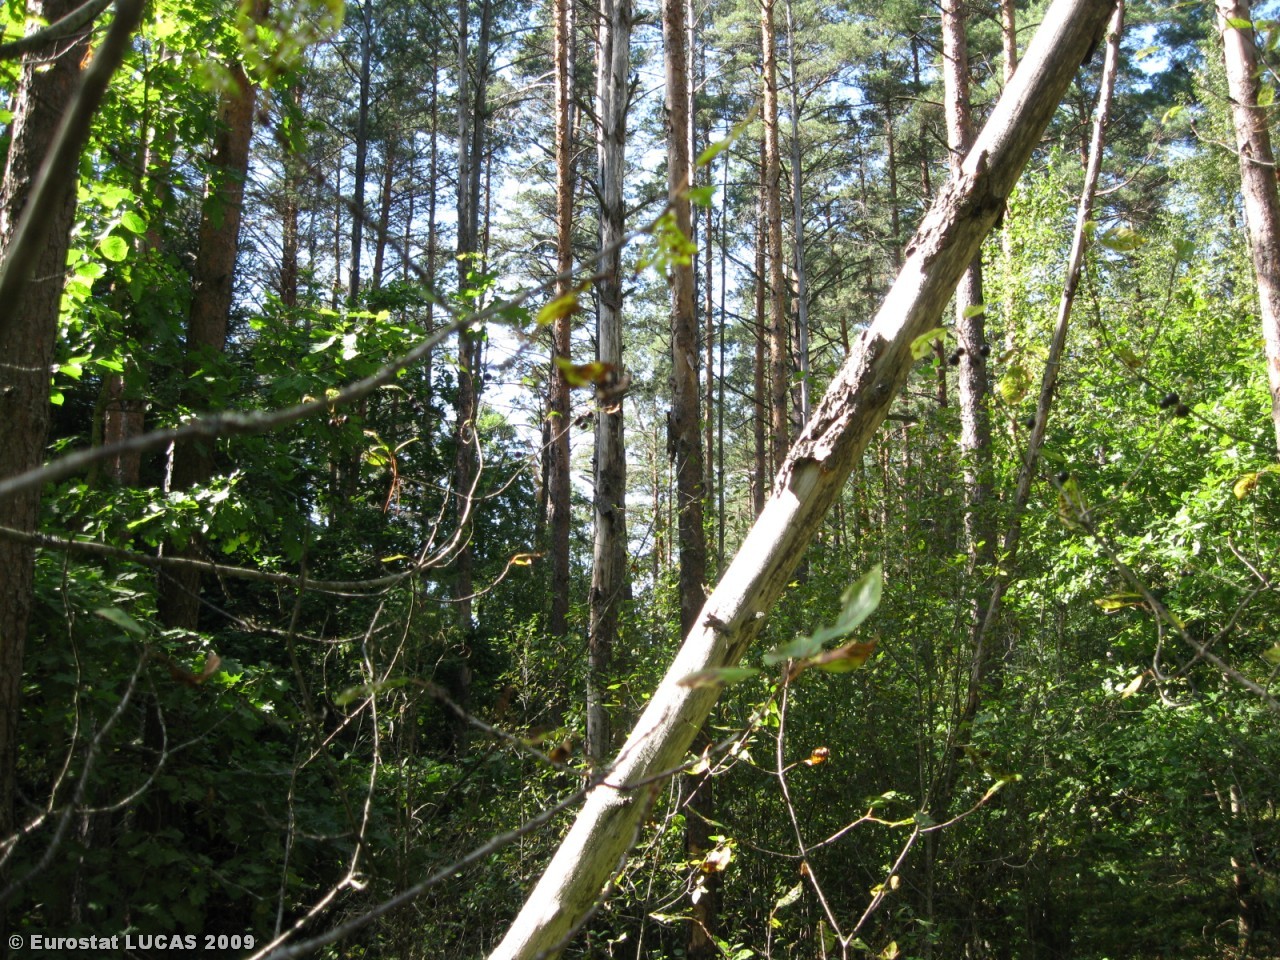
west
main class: Woodland
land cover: Mixed woodland
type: hemiboreal forest and nemoral coniferous forest and mixed broadleaved-coniferous forest
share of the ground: > 75 %
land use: Forestry
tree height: > 5 m
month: August
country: LT
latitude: 54.3173
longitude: 24.6338
